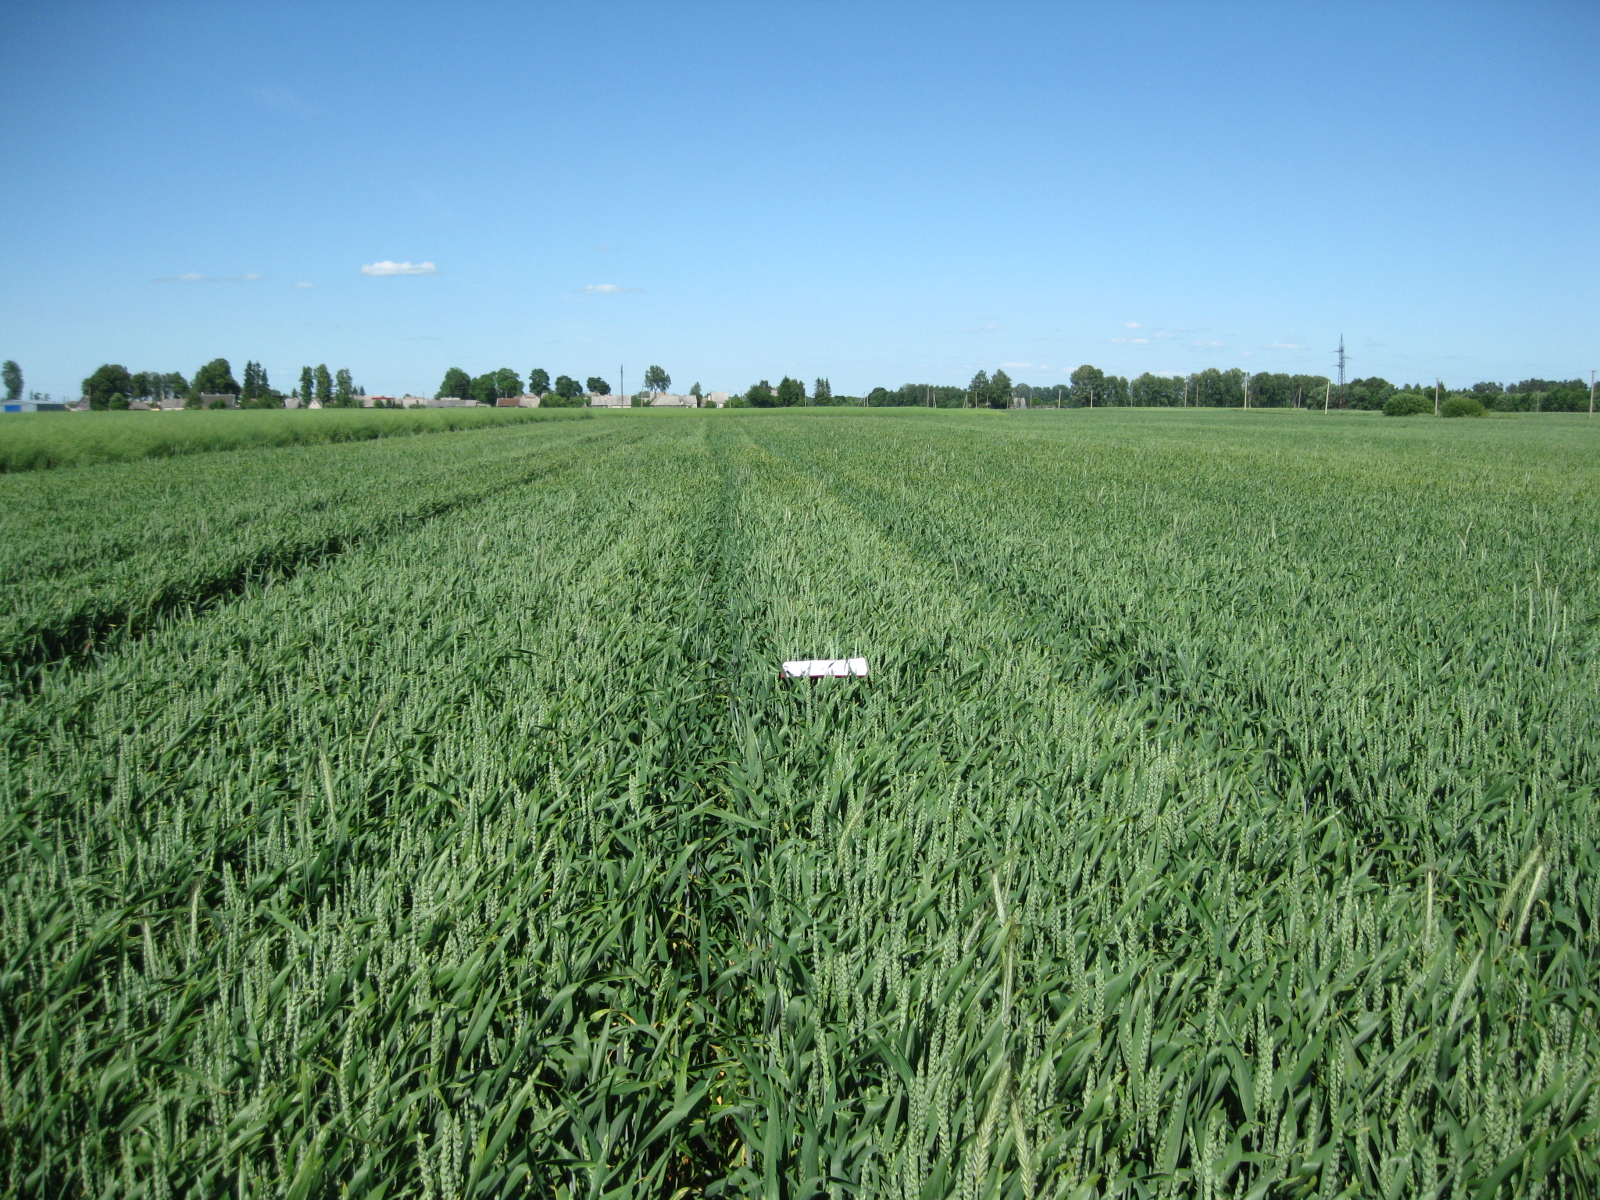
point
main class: Cropland
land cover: Common wheat
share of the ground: > 75 %
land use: Agriculture (excluding fallow land and kitchen gardens)
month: June
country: LT
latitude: 55.2557
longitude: 23.7893
